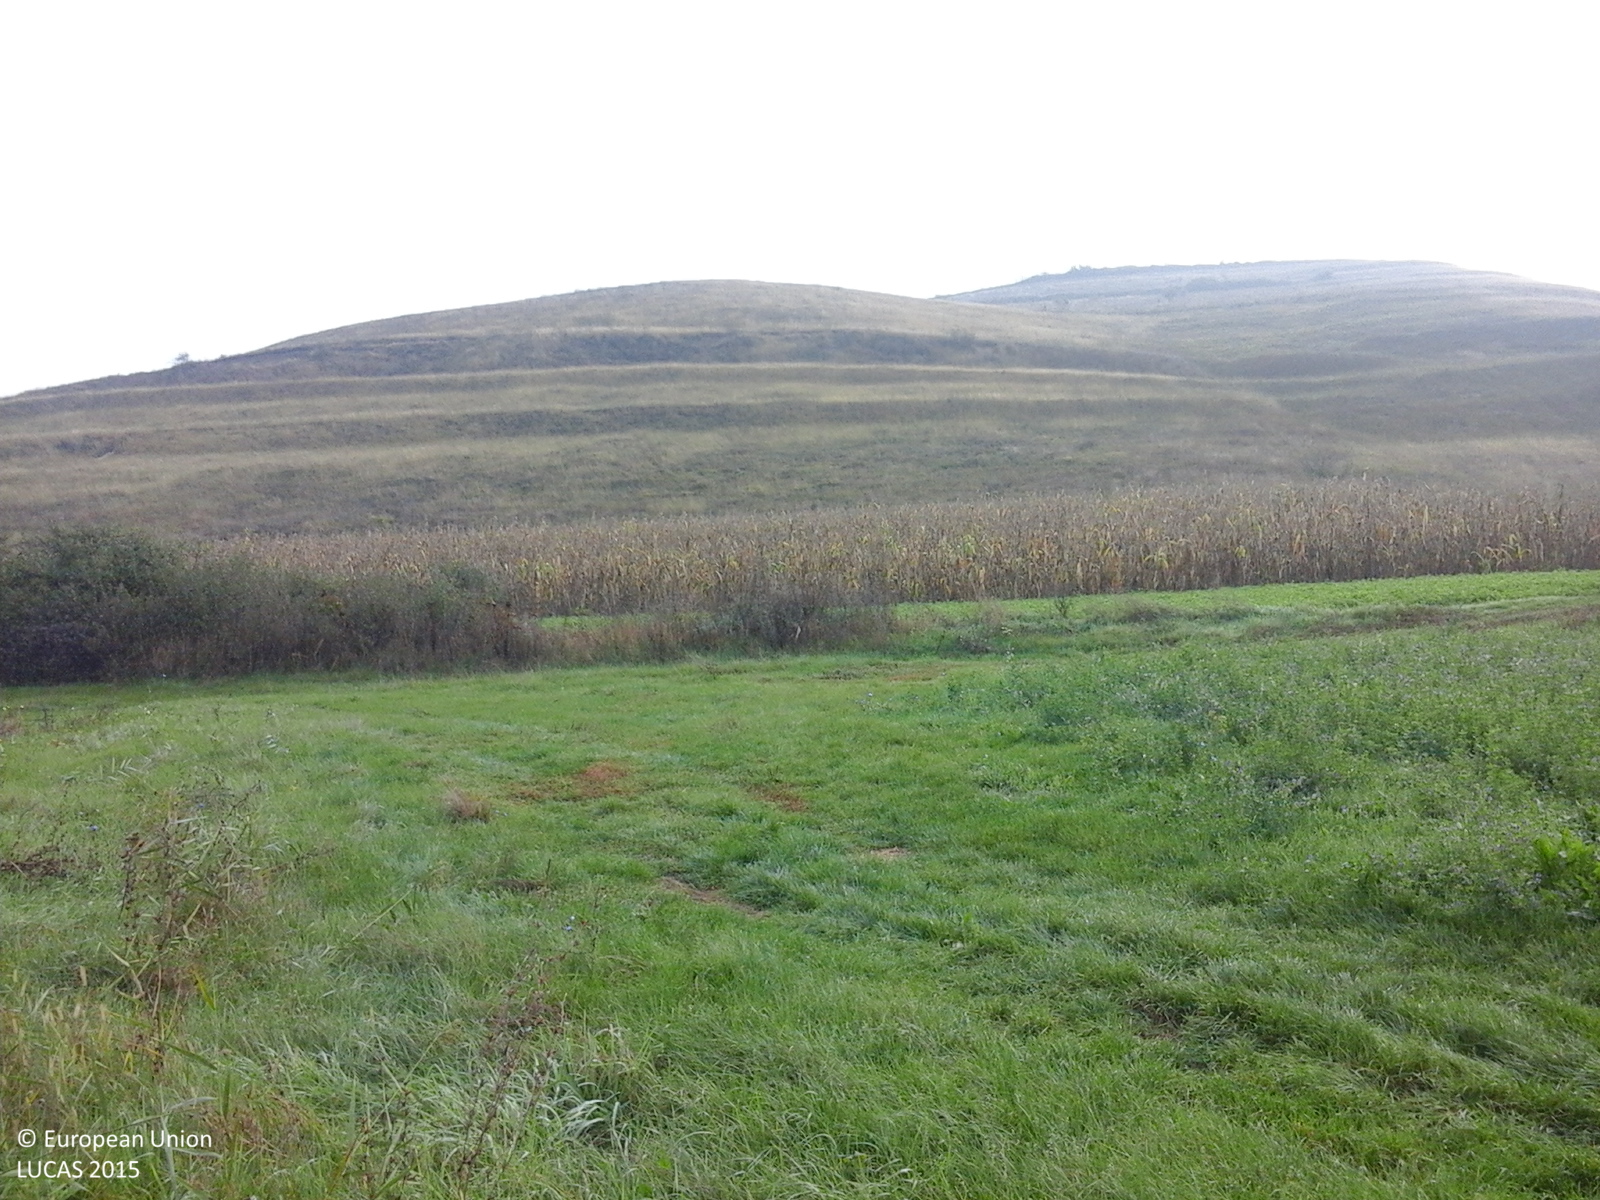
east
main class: Grassland
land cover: Spontaneously vegetated surfaces
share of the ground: > 75 %
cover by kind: herbaceous plants 100 %
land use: Agriculture (excluding fallow land and kitchen gardens)
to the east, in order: Spontaneously vegetated surfaces; Tracks; Lucerne; Tracks; Lucerne; Maize; Grassland without tree/shrub cover
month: October
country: RO
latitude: 46.0186
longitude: 23.9320
